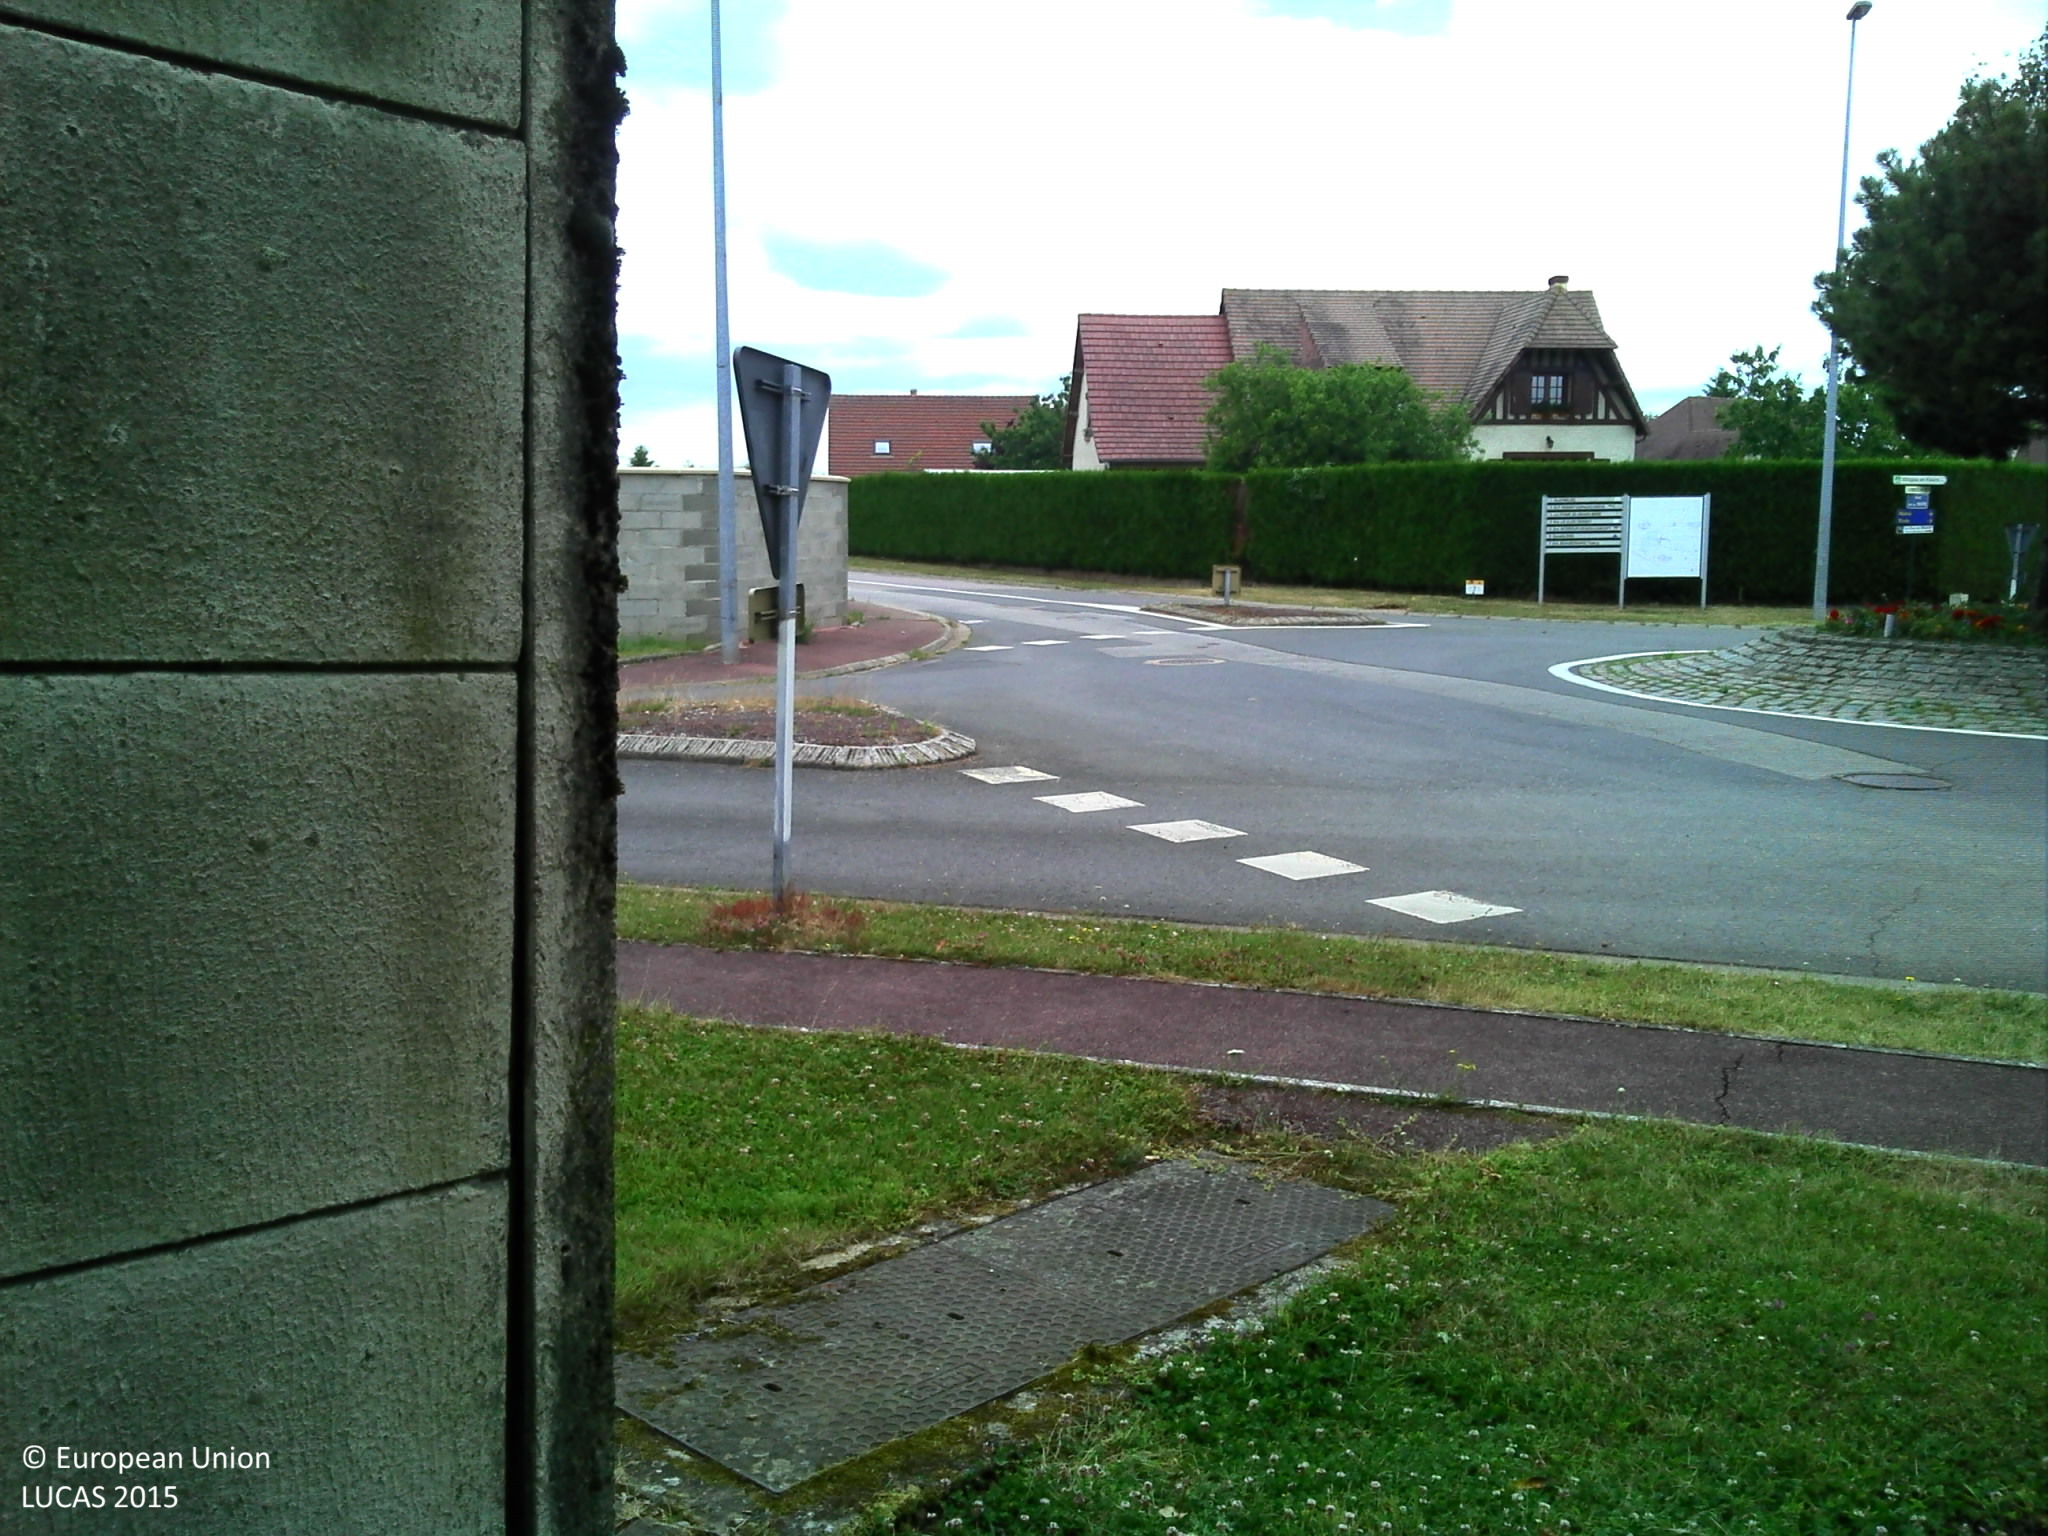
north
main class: Grassland
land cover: Grassland with sparse tree/shrub cover
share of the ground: > 75 %
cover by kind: herbaceous plants 95 %, broadleaved forest trees 5 %
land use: Residential
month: June
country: FR
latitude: 49.0325
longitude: 1.2401
